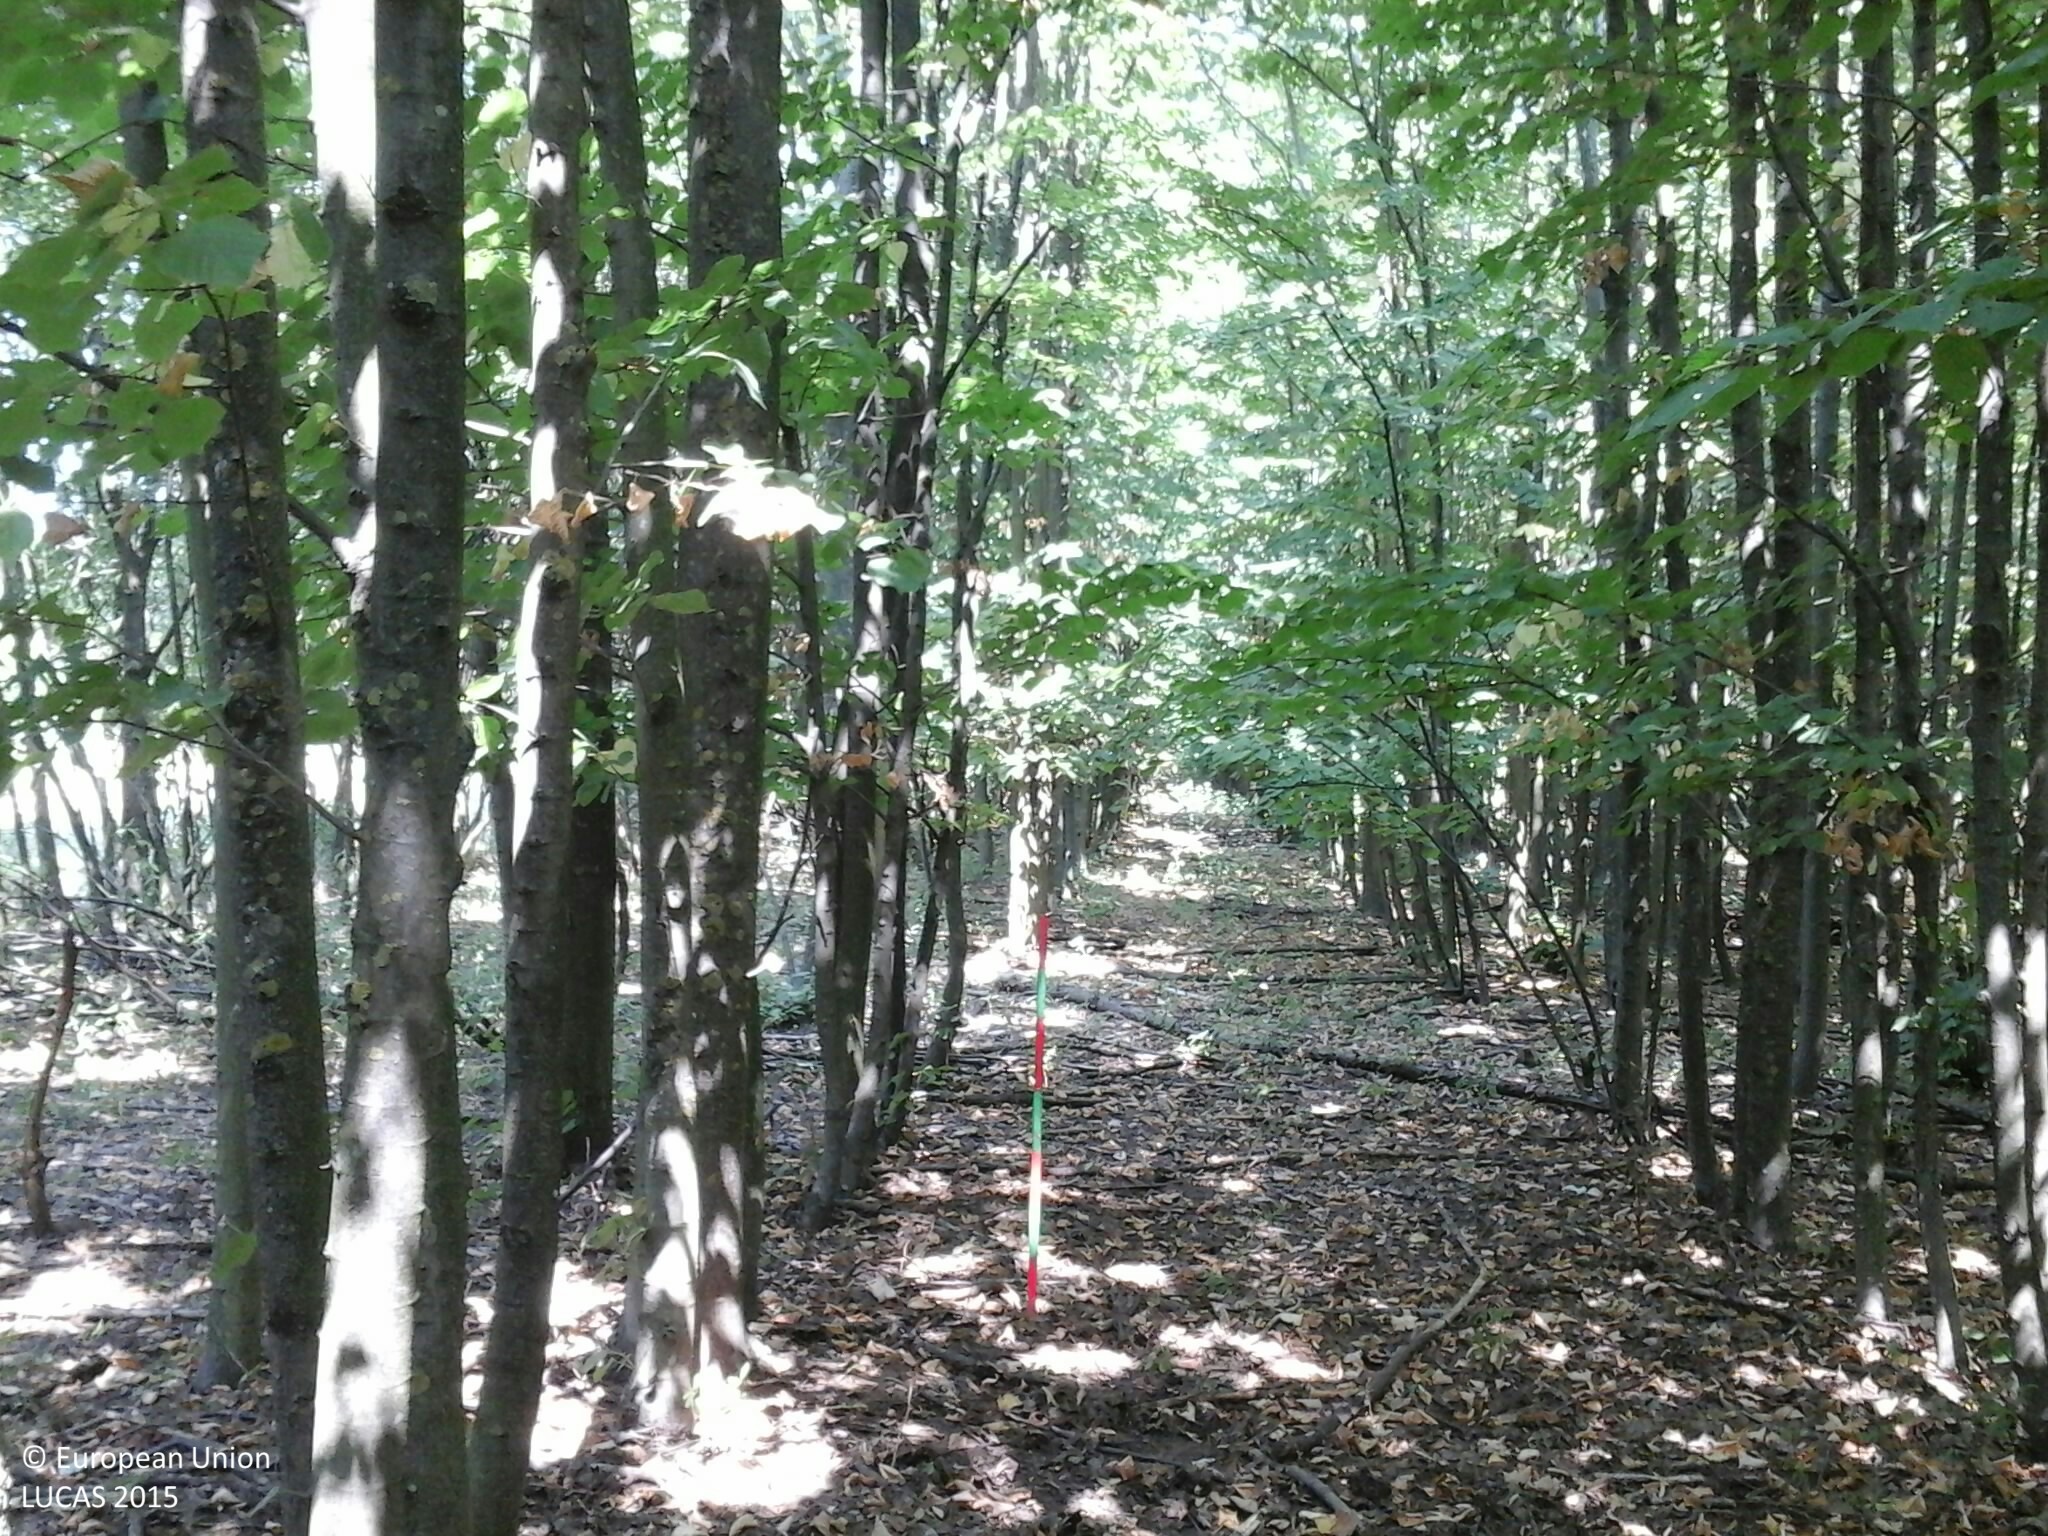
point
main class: Woodland
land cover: Broadleaved woodland
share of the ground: > 75 %
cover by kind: broadleaved forest trees 100 %
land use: Forestry
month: August
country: HU
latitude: 46.9214
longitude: 18.2176
